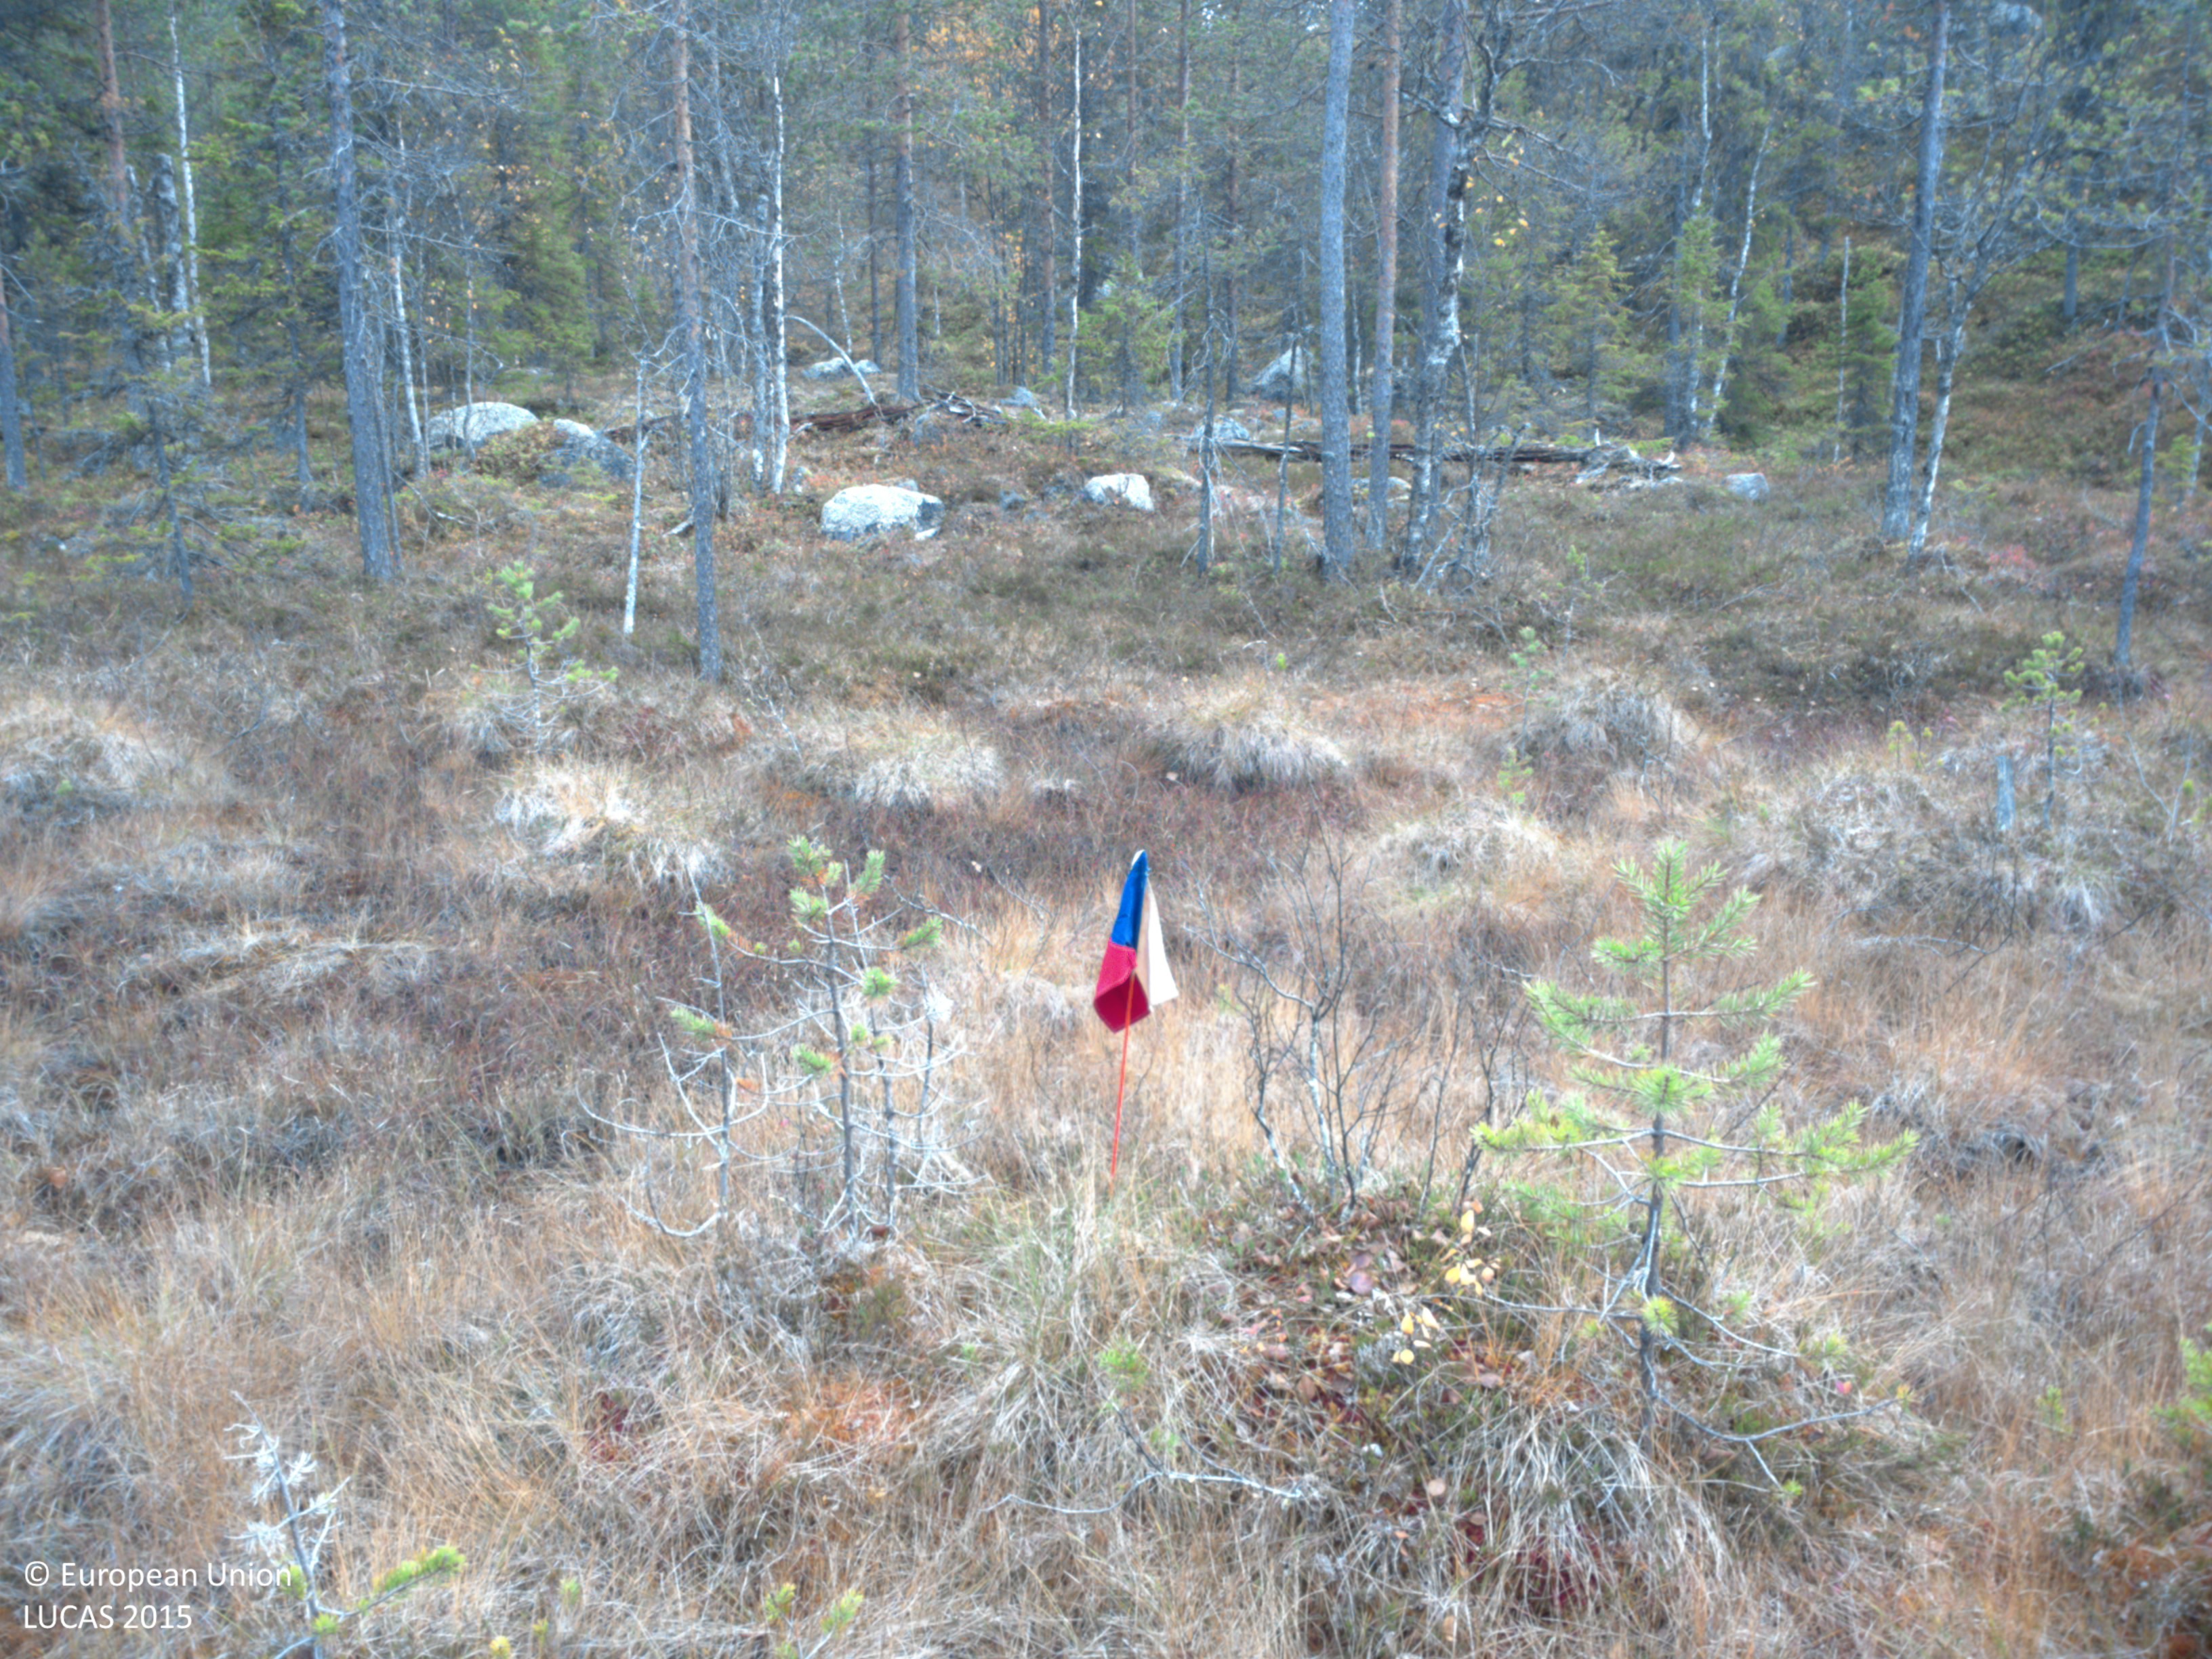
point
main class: Woodland
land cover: Pine dominated coniferous woodland
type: mire and swamp forests
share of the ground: 10 - 25 %
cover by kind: coniferous forest trees 30 %, shrubs 30 %, herbaceous plants 30 %, lichens and mosses 10 %
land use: Semi-natural and natural areas not in use
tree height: < 5 m
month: September
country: SE
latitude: 65.0015
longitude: 18.5961
